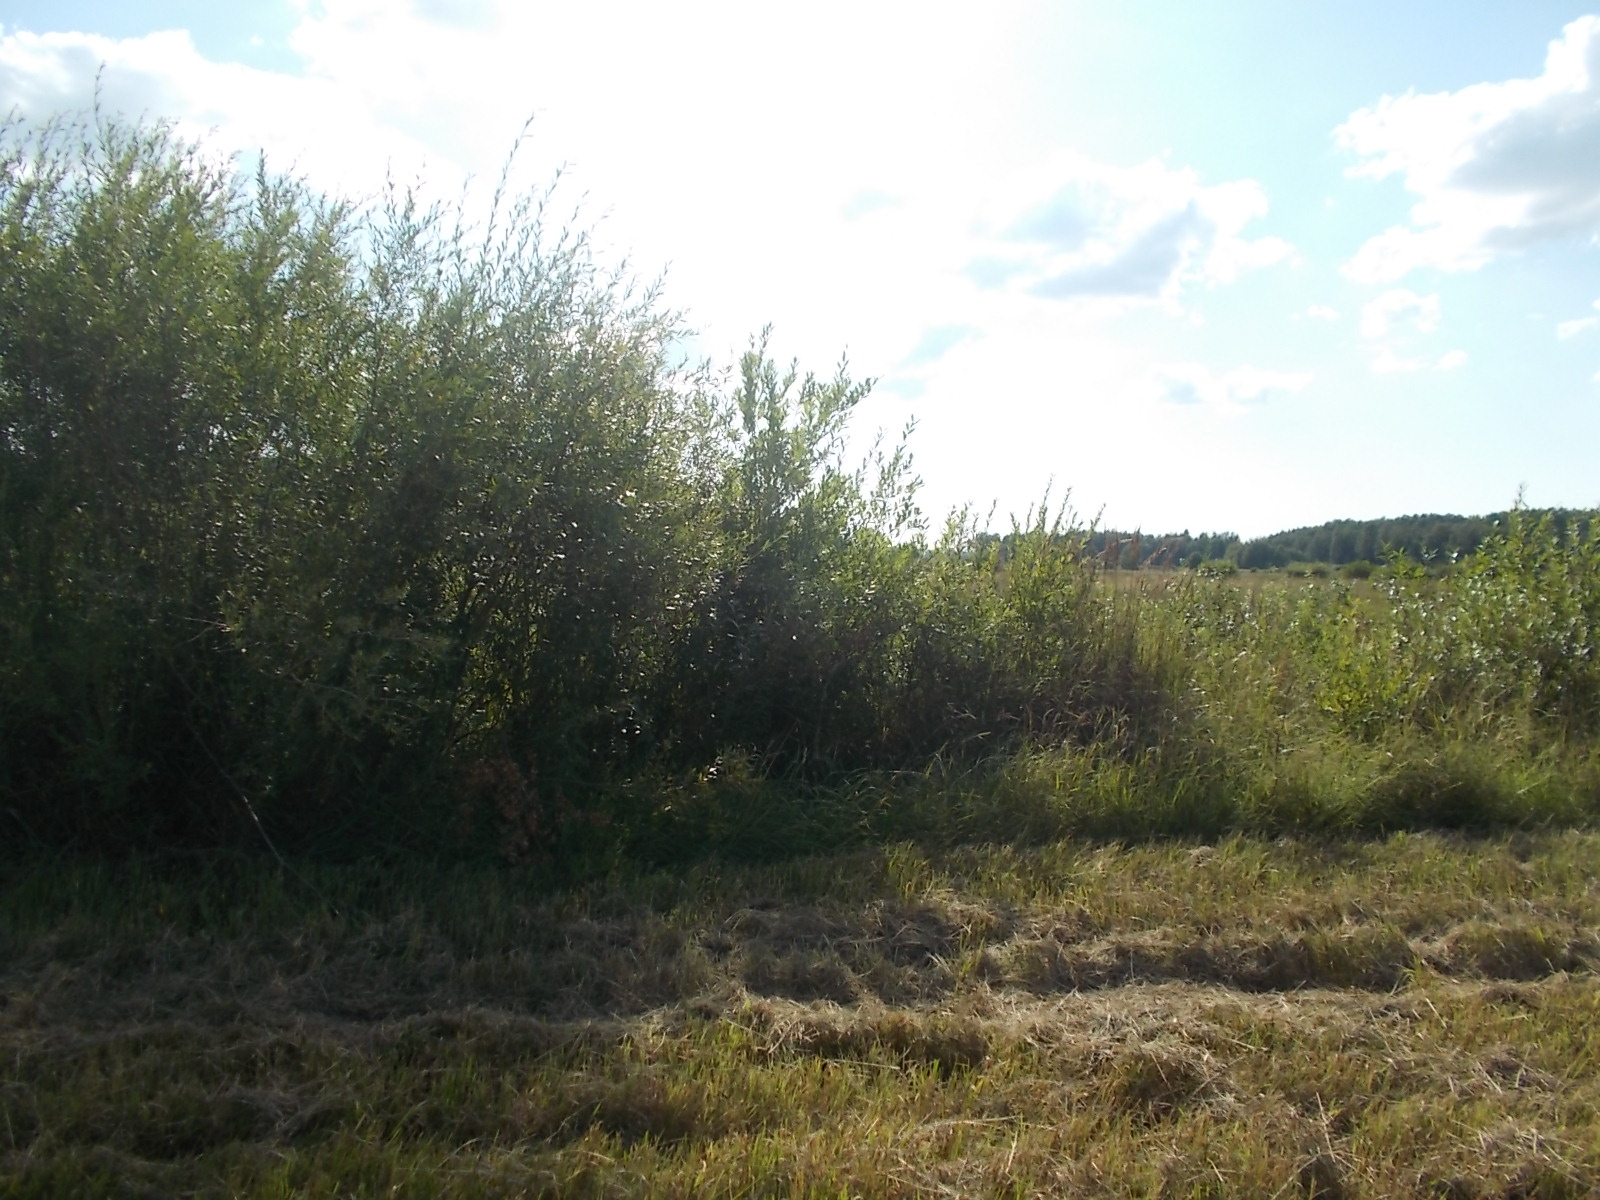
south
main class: Grassland
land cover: Grassland without tree/shrub cover
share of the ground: > 75 %
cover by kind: herbaceous plants 100 %
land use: Agriculture (excluding fallow land and kitchen gardens)
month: August
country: LV
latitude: 57.0662
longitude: 21.7360
